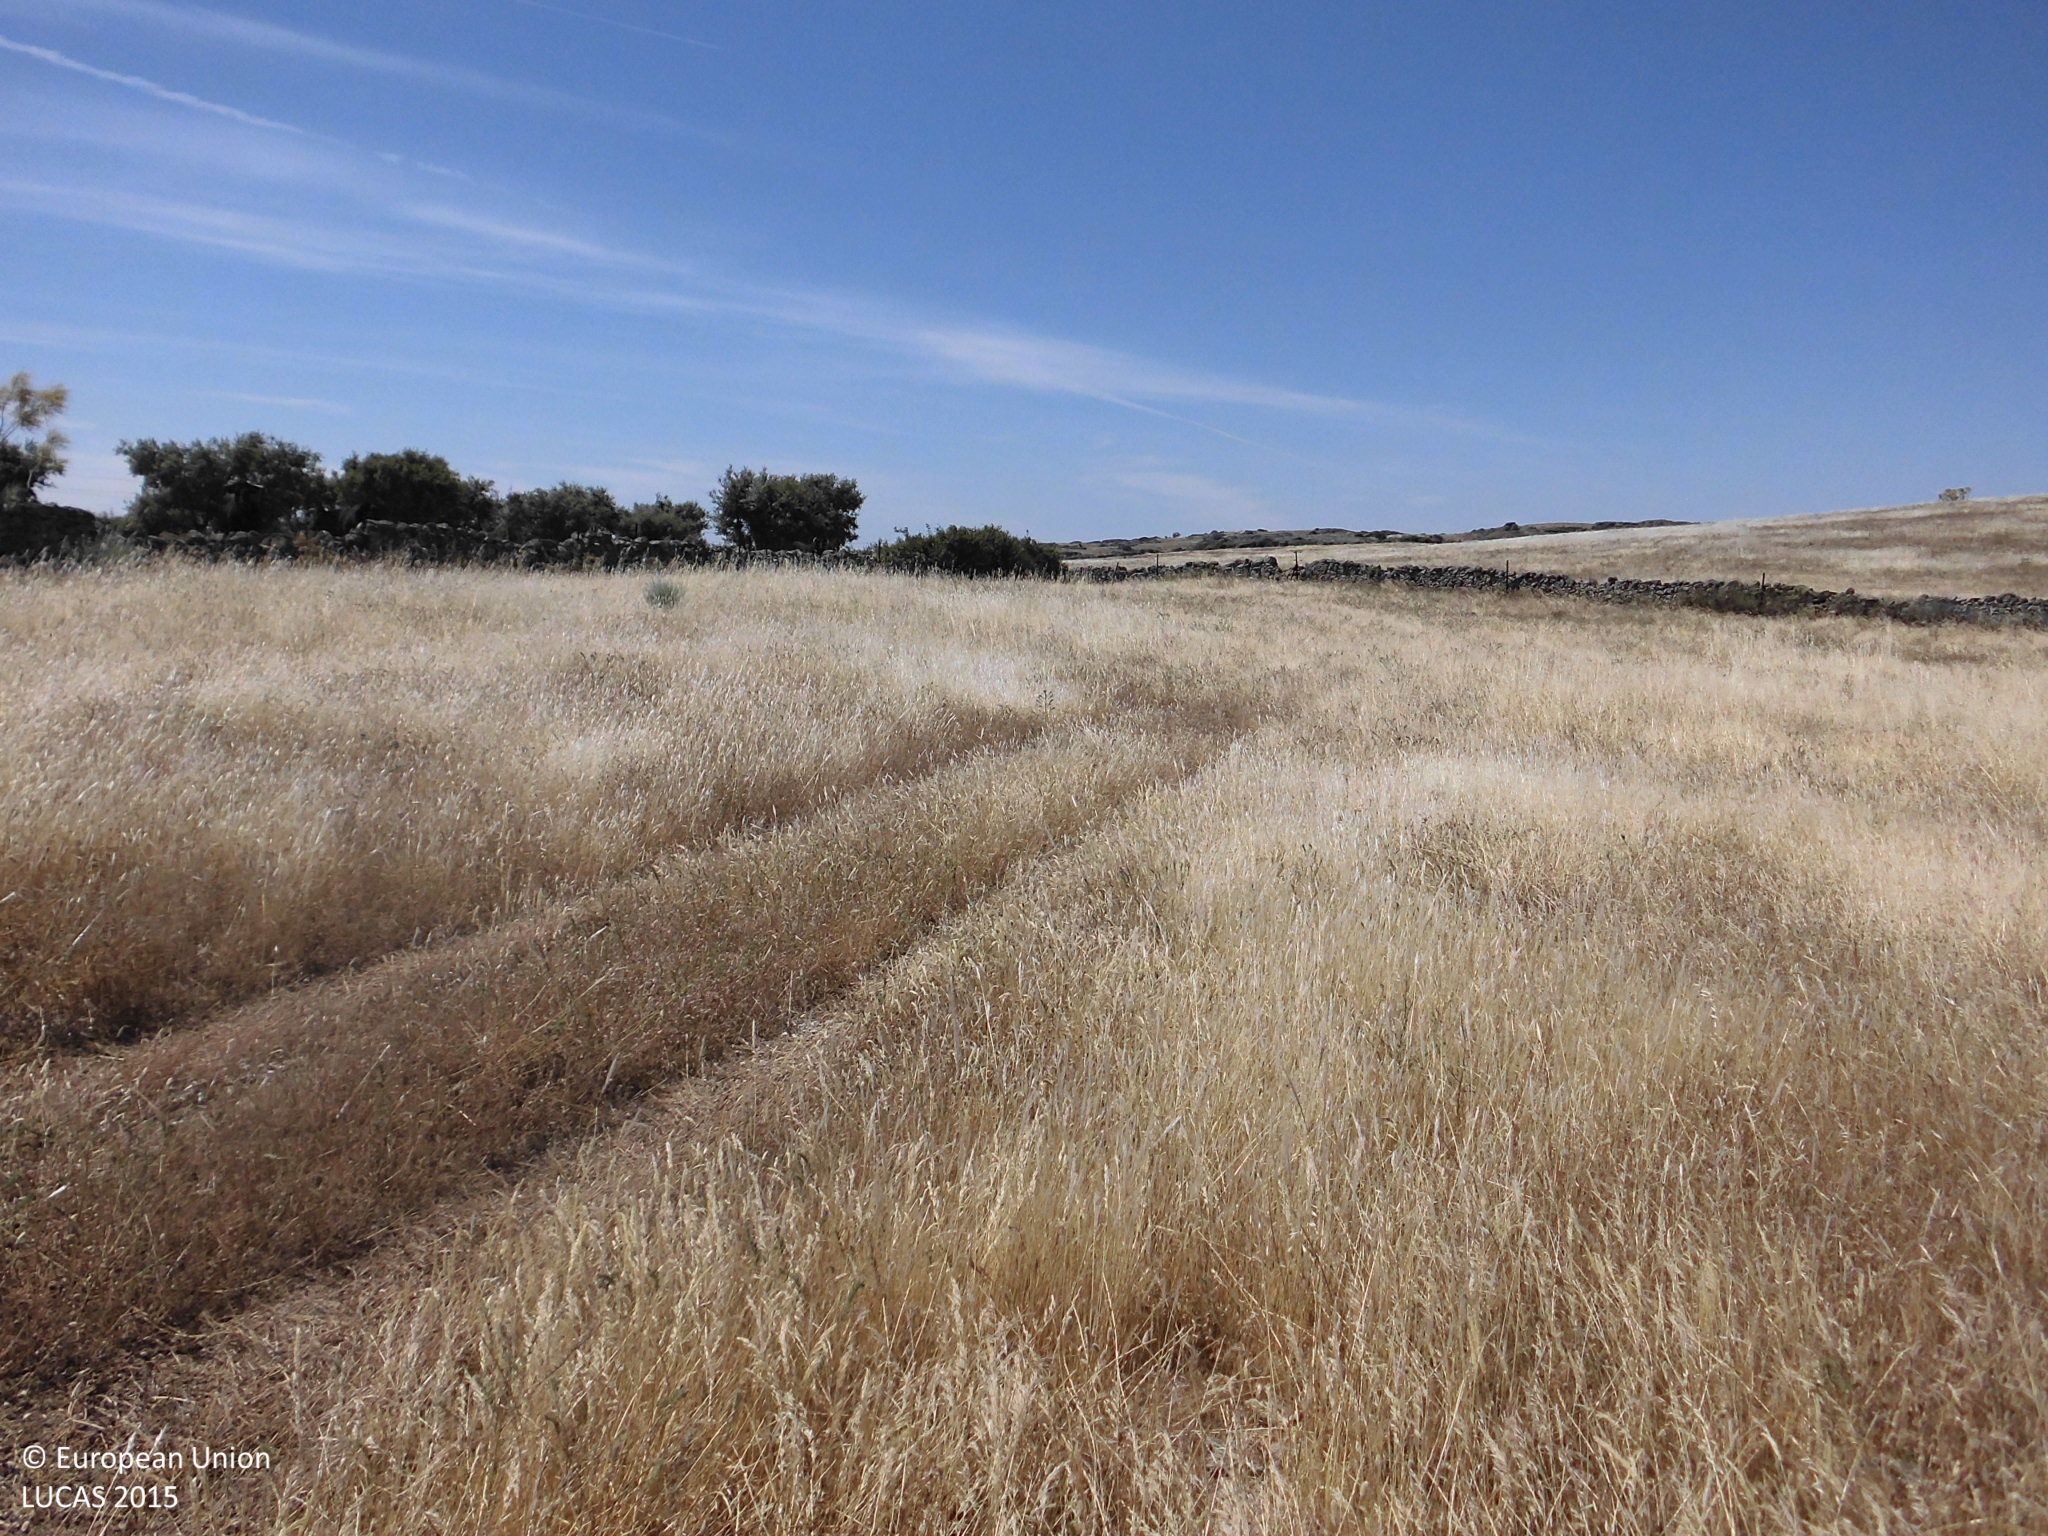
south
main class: Grassland
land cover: Grassland without tree/shrub cover
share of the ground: > 75 %
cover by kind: herbaceous plants 100 %
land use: Agriculture (excluding fallow land and kitchen gardens)
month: May
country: ES
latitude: 39.6994
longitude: -6.6497
